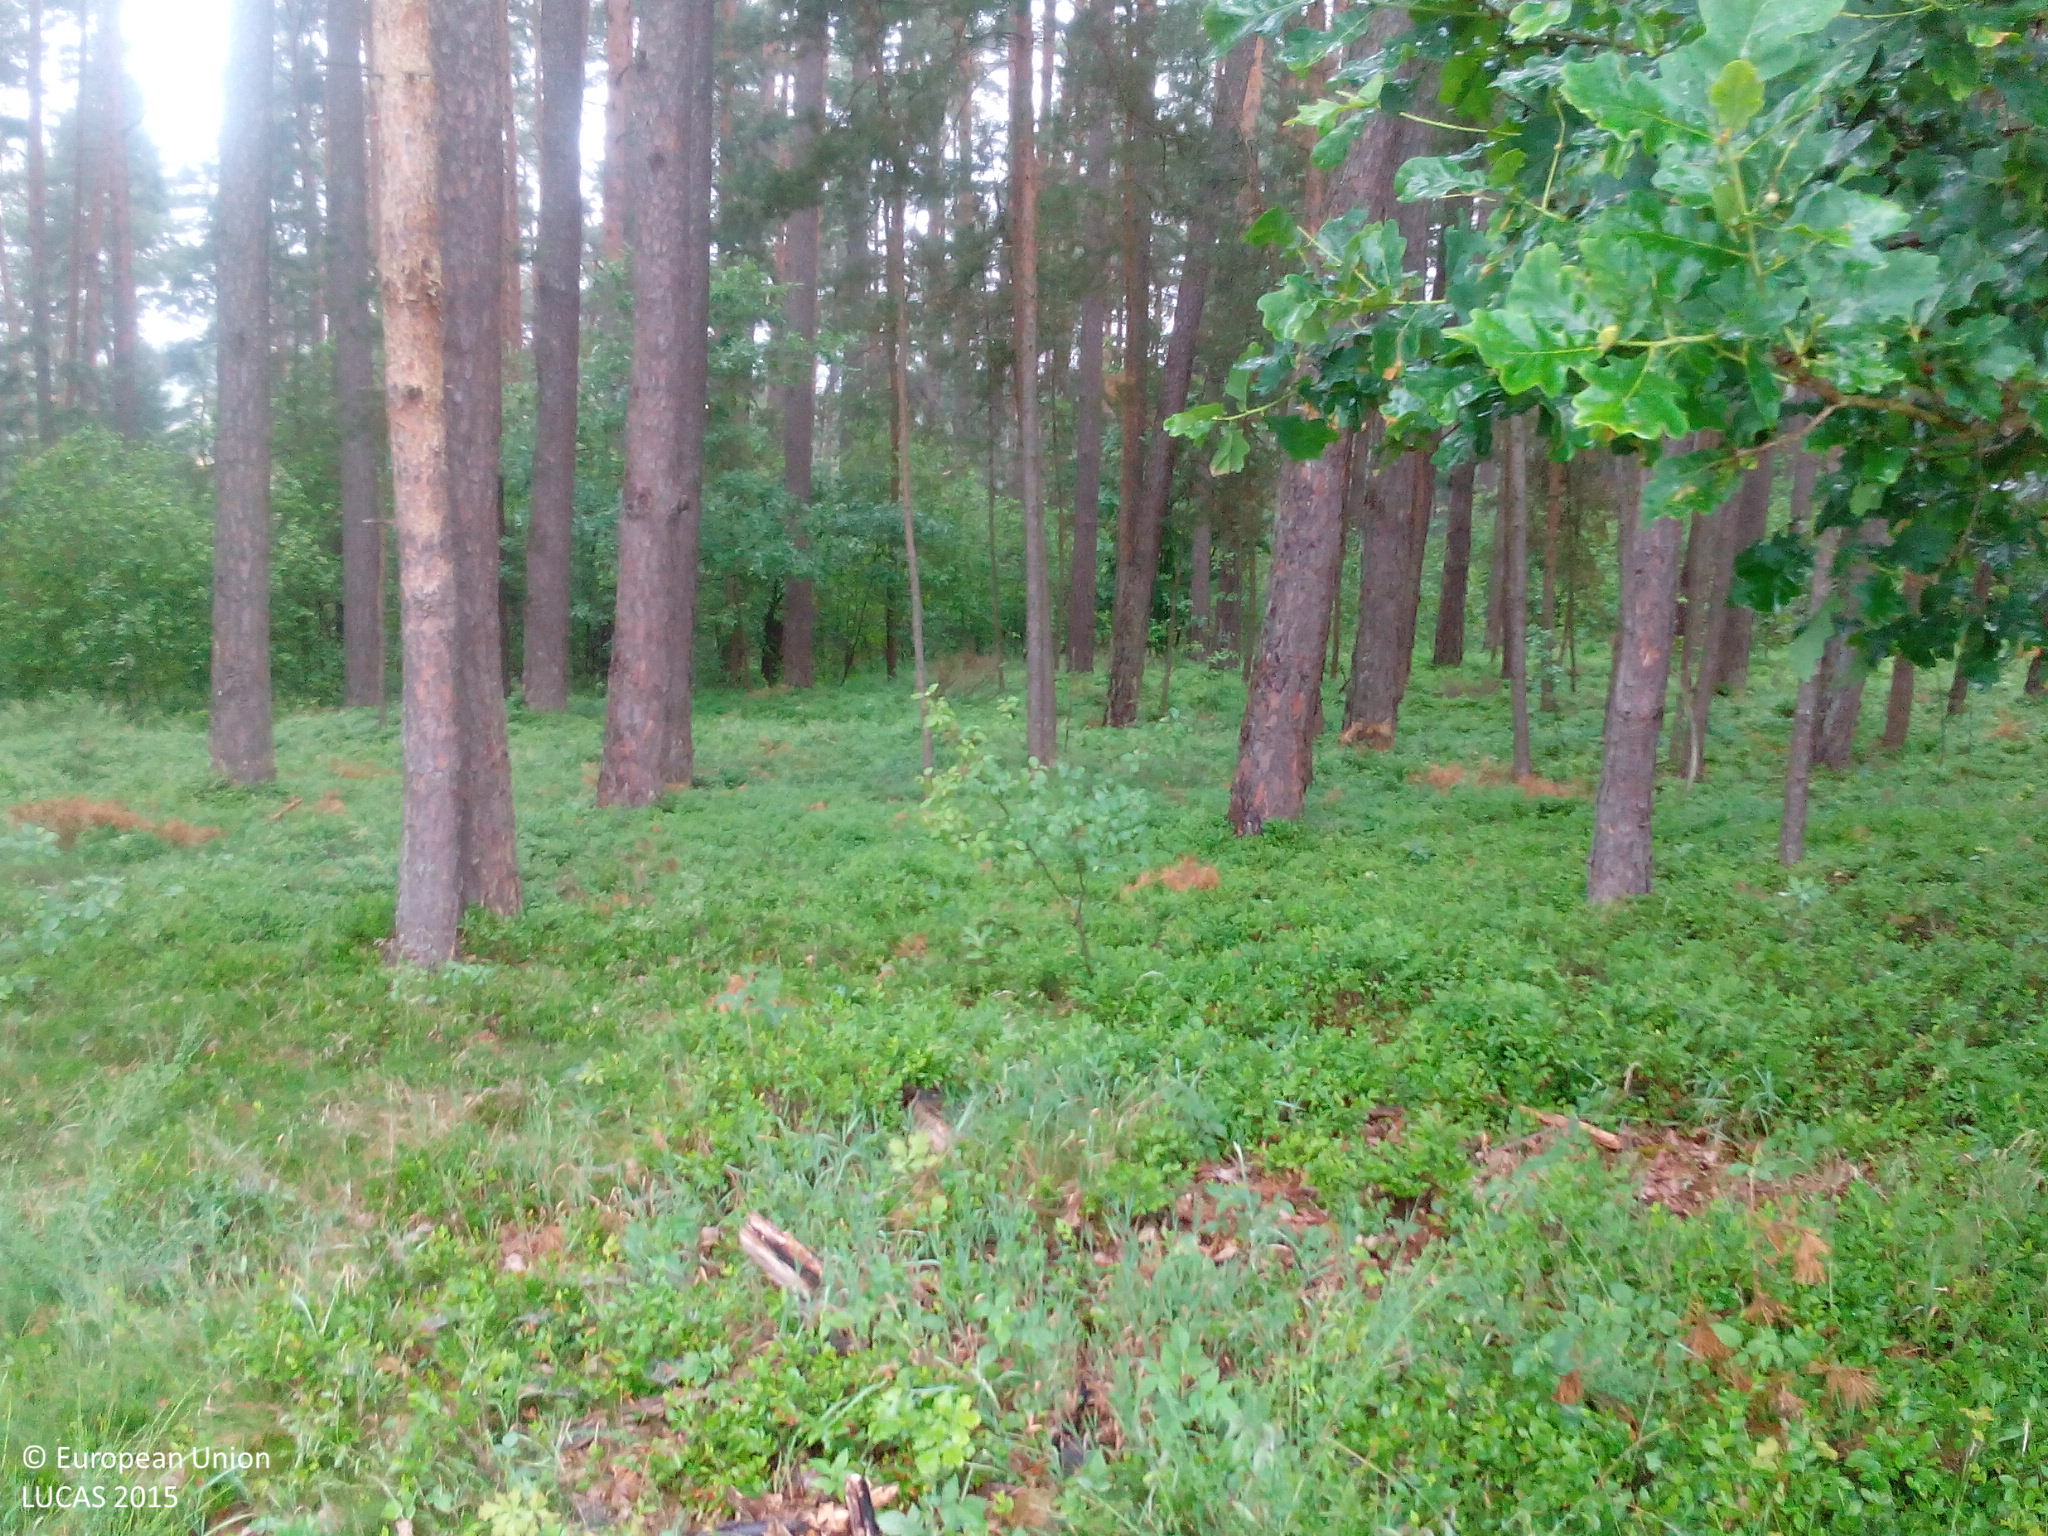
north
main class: Woodland
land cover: Pine dominated coniferous woodland
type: hemiboreal forest and nemoral coniferous forest and mixed broadleaved-coniferous forest
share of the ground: > 75 %
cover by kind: coniferous forest trees 75 %, herbaceous plants 20 %, broadleaved forest trees 5 %
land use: Forestry
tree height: > 5 m
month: June
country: DE
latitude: 49.2814
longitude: 10.8932
